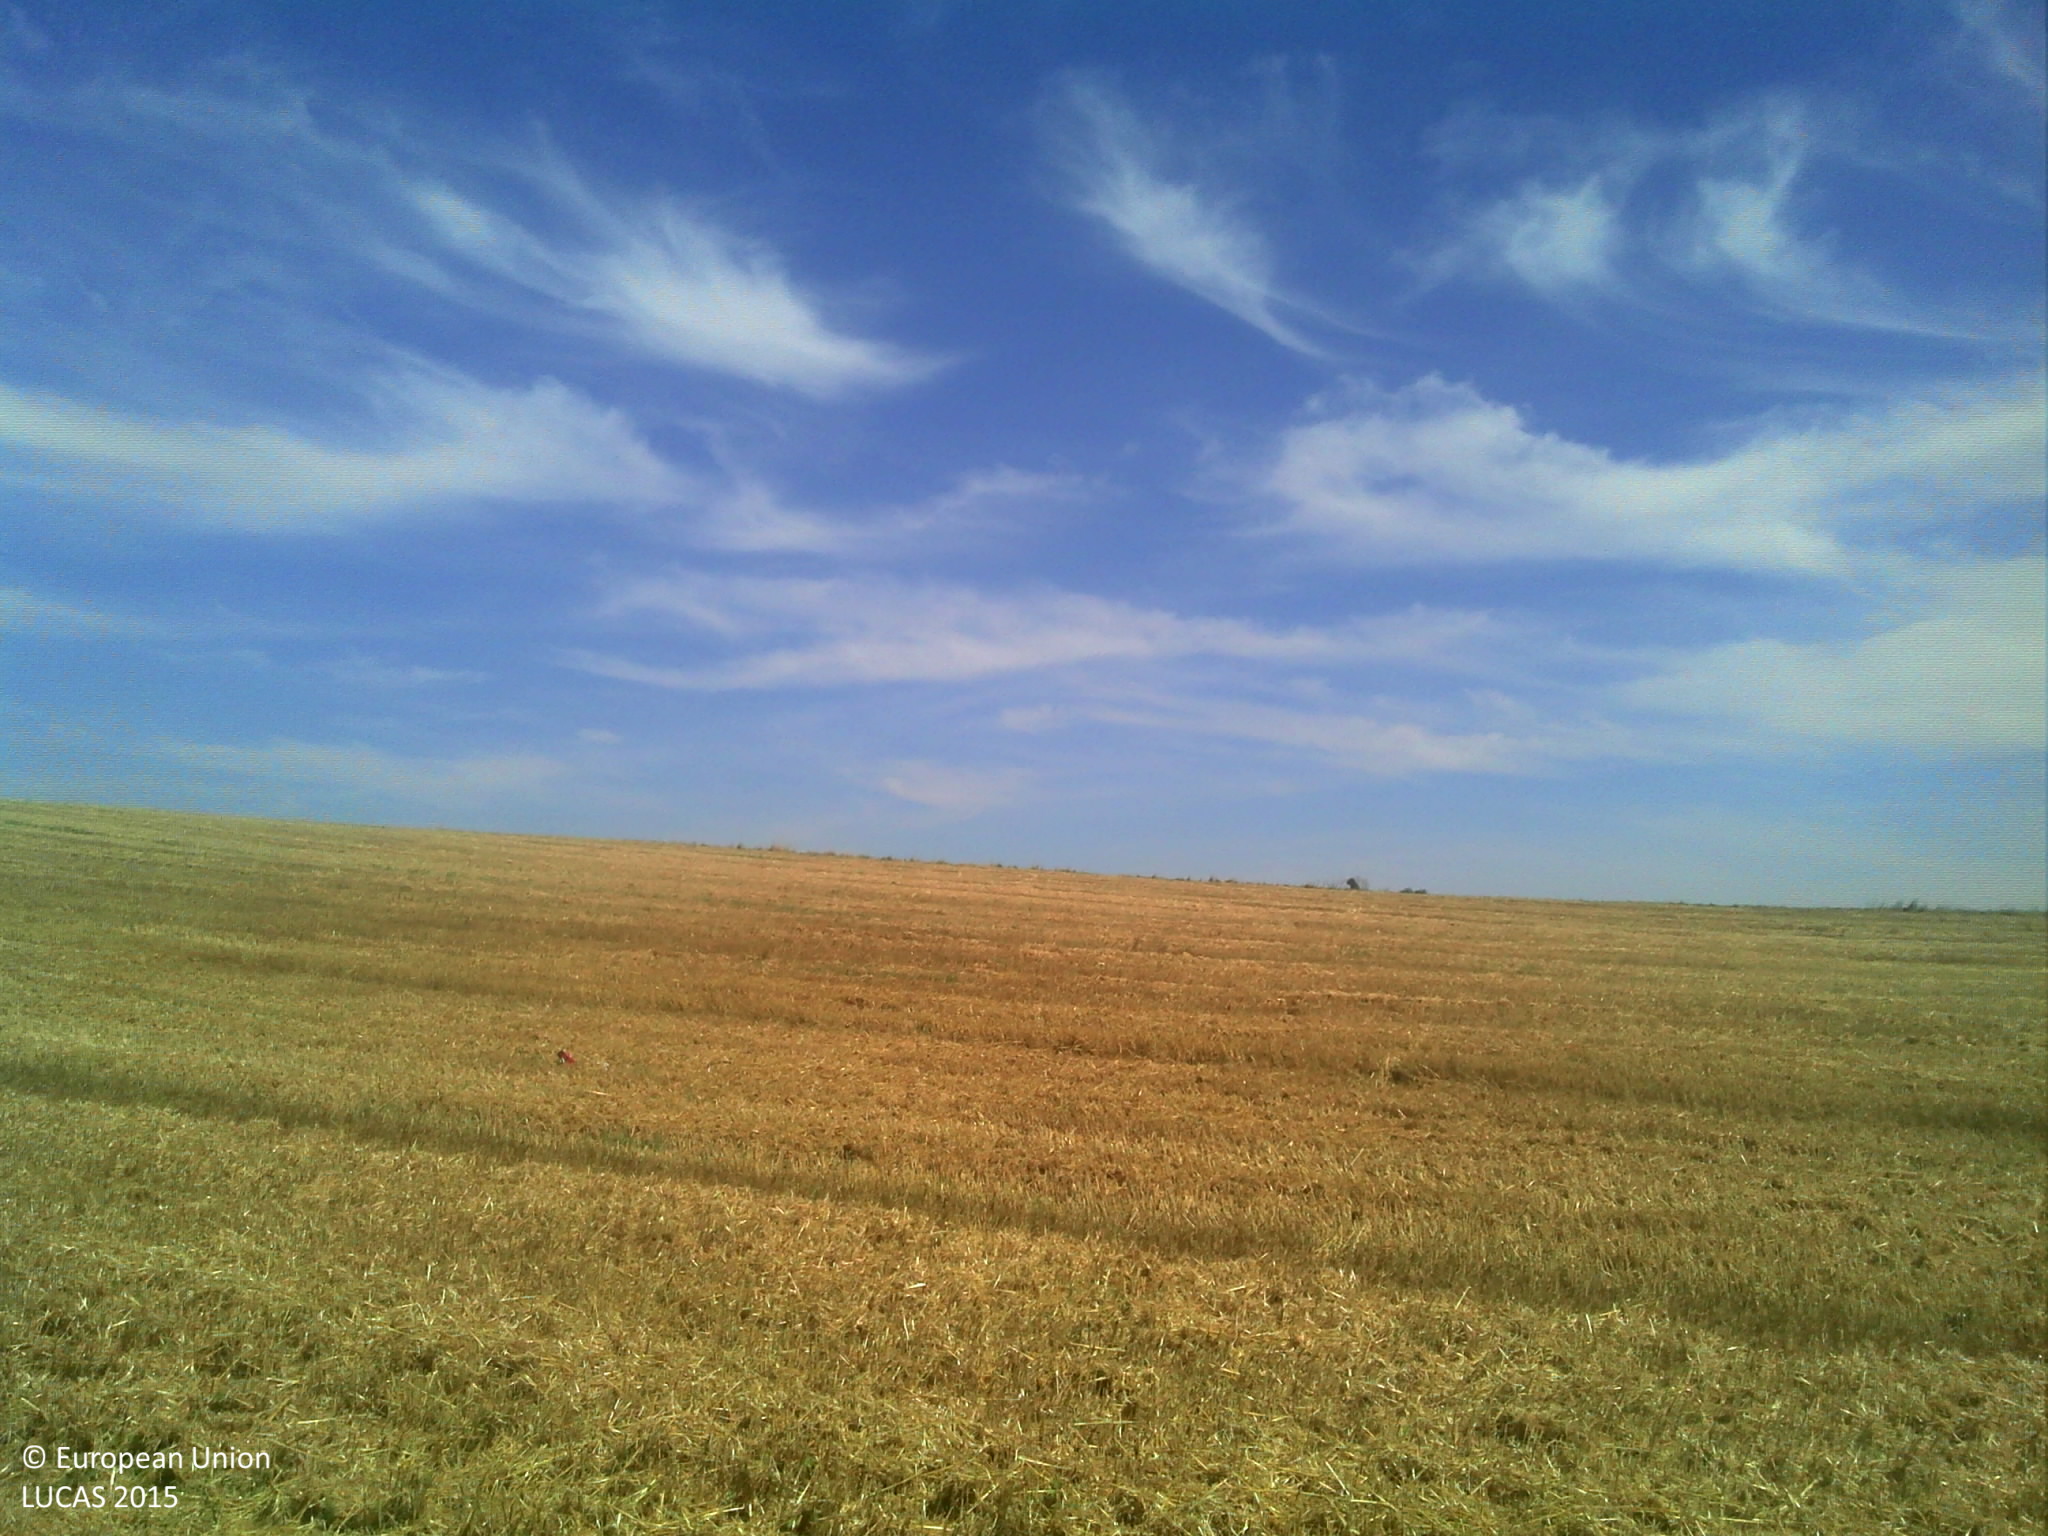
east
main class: Cropland
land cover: Durum wheat
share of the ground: > 75 %
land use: Agriculture (excluding fallow land and kitchen gardens)
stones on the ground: < 10 %
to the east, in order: Durum wheat; Grass margins; Tracks; Grass margins; Durum wheat
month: July
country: FR
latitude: 43.5061
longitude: 1.4316
